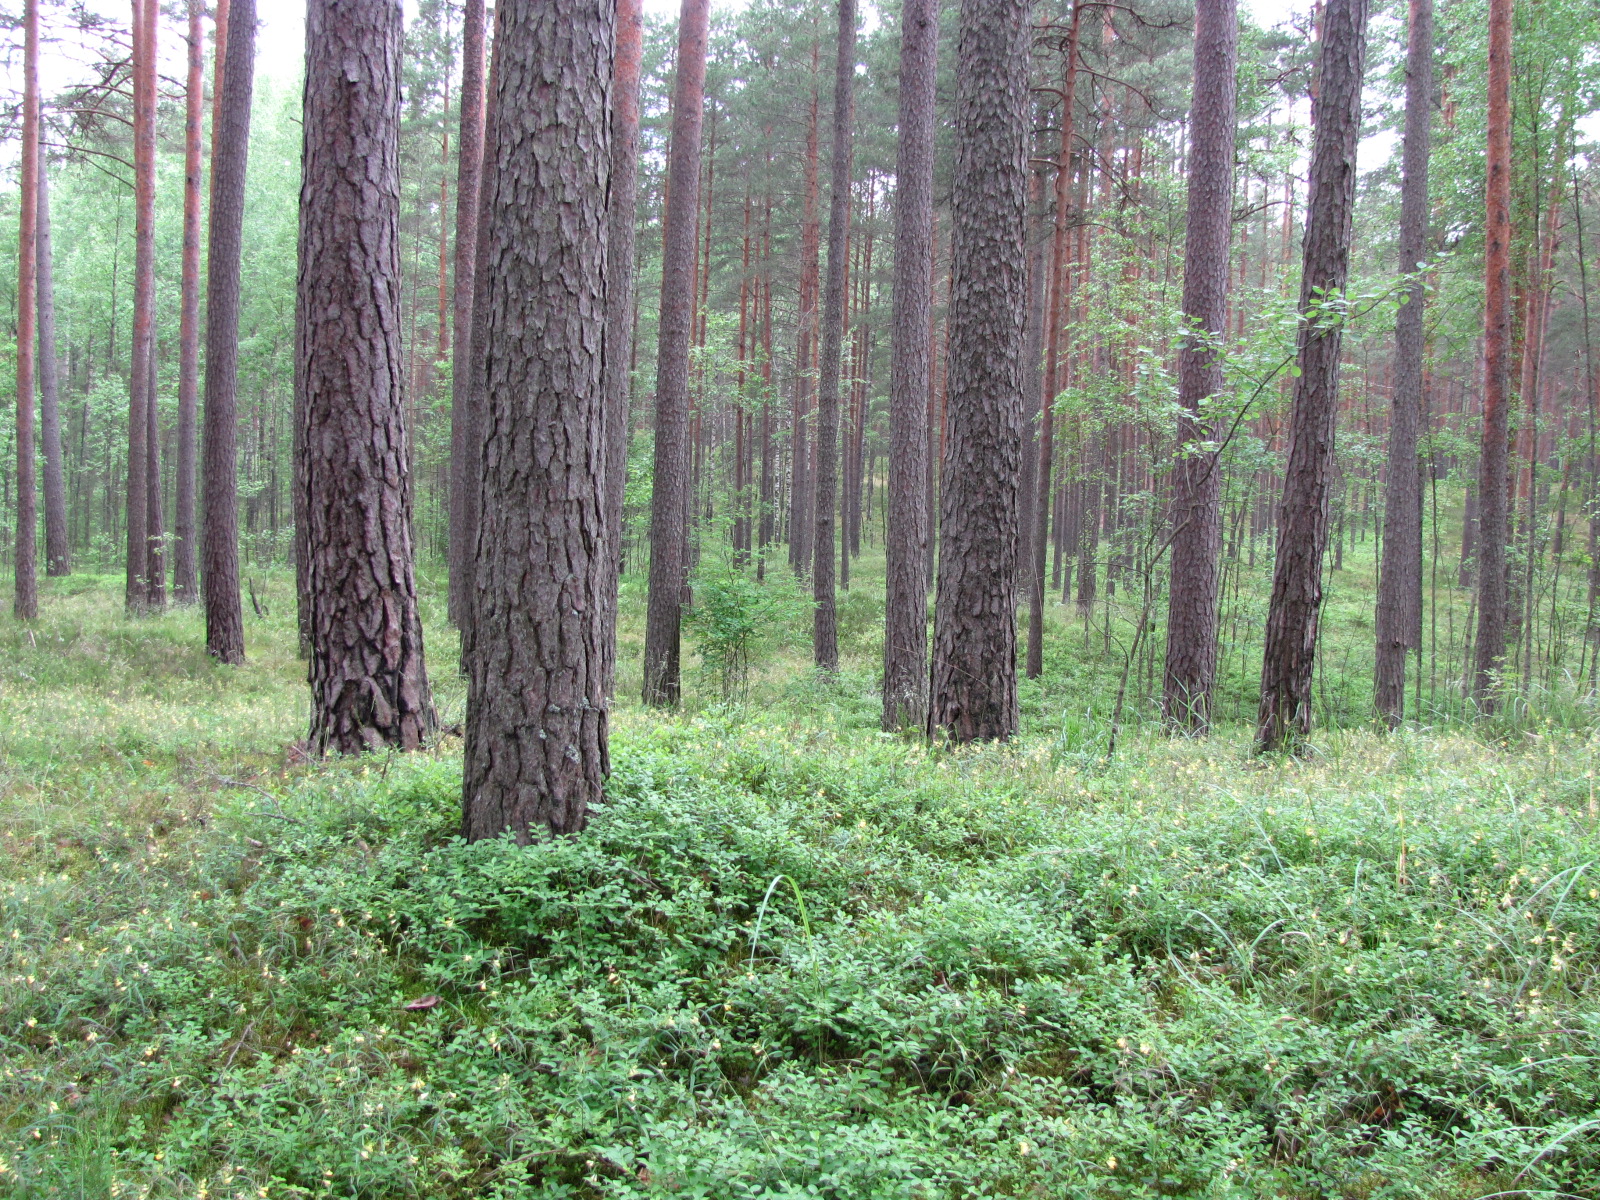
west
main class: Woodland
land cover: Pine dominated coniferous woodland
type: hemiboreal forest and nemoral coniferous forest and mixed broadleaved-coniferous forest
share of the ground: > 75 %
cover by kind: coniferous forest trees 80 %, herbaceous plants 10 %, lichens and mosses 10 %
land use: Forestry
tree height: > 5 m
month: June
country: LV
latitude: 56.9219
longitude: 23.9308
